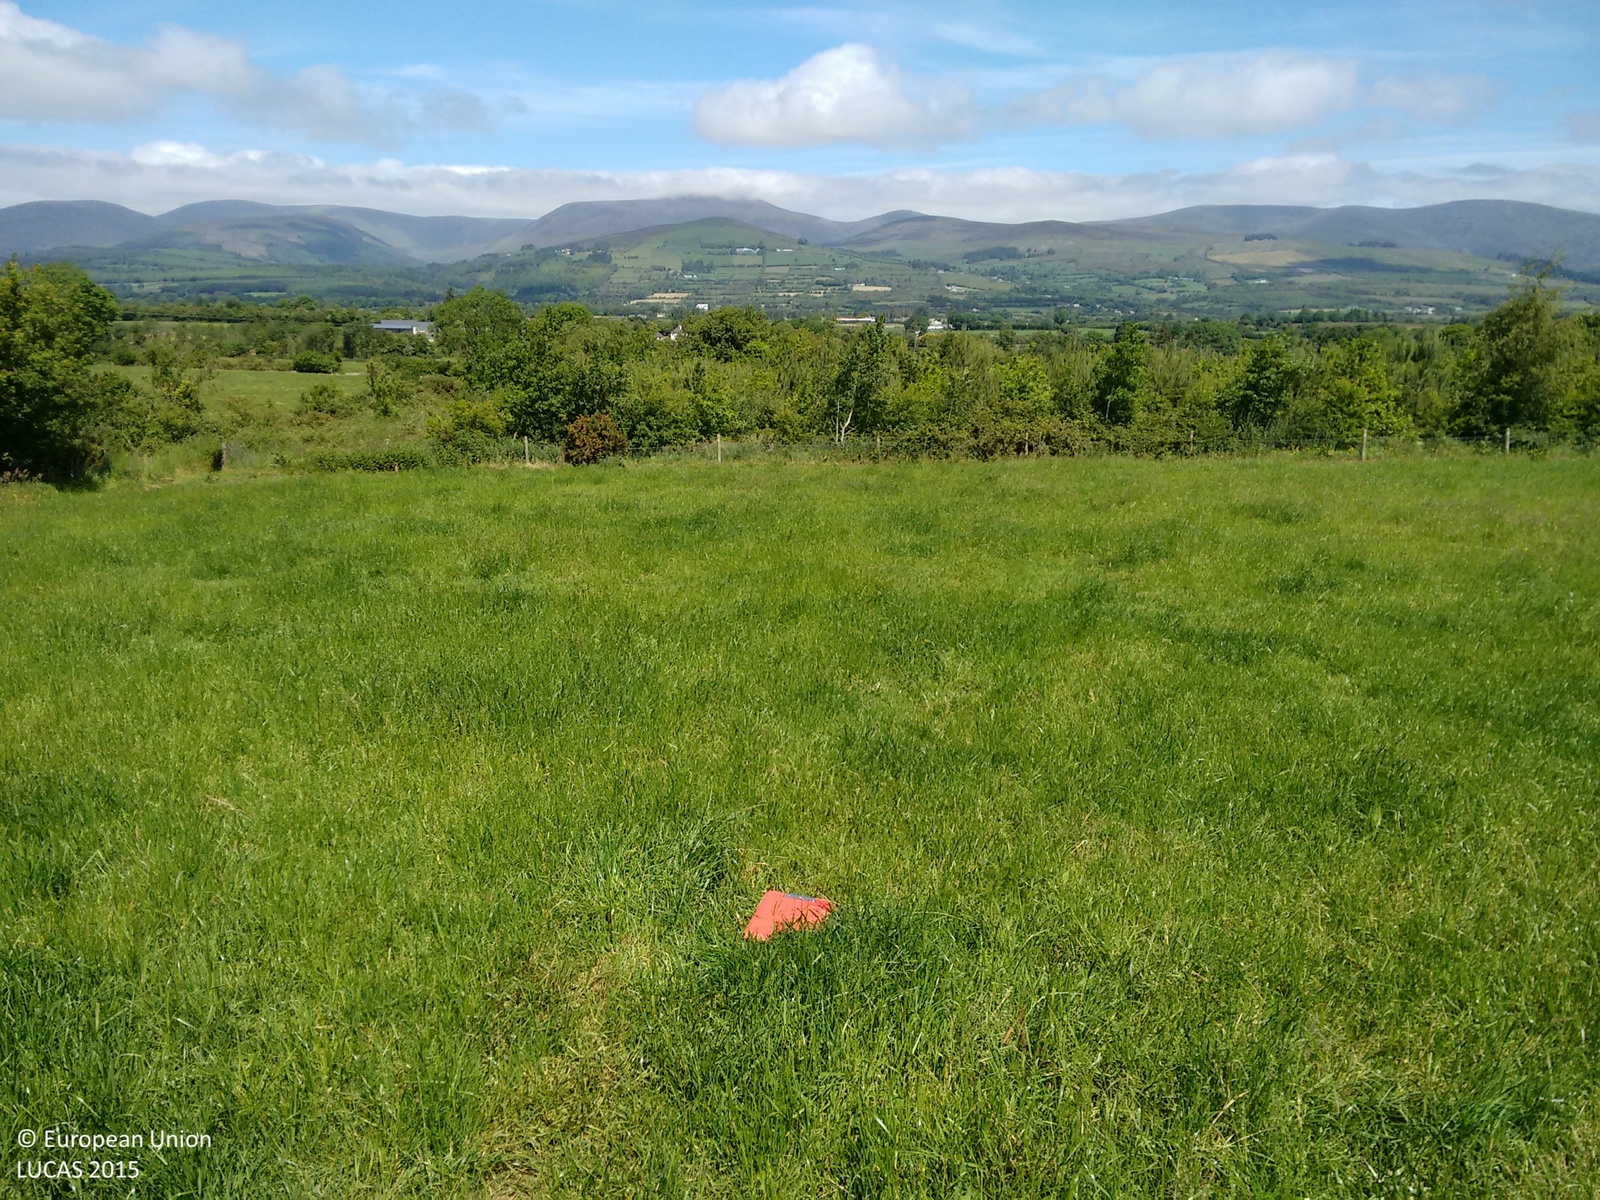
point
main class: Grassland
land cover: Grassland without tree/shrub cover
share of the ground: > 75 %
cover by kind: herbaceous plants 100 %
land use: Agriculture (excluding fallow land and kitchen gardens)
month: June
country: IE
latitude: 52.2910
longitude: -8.1411
